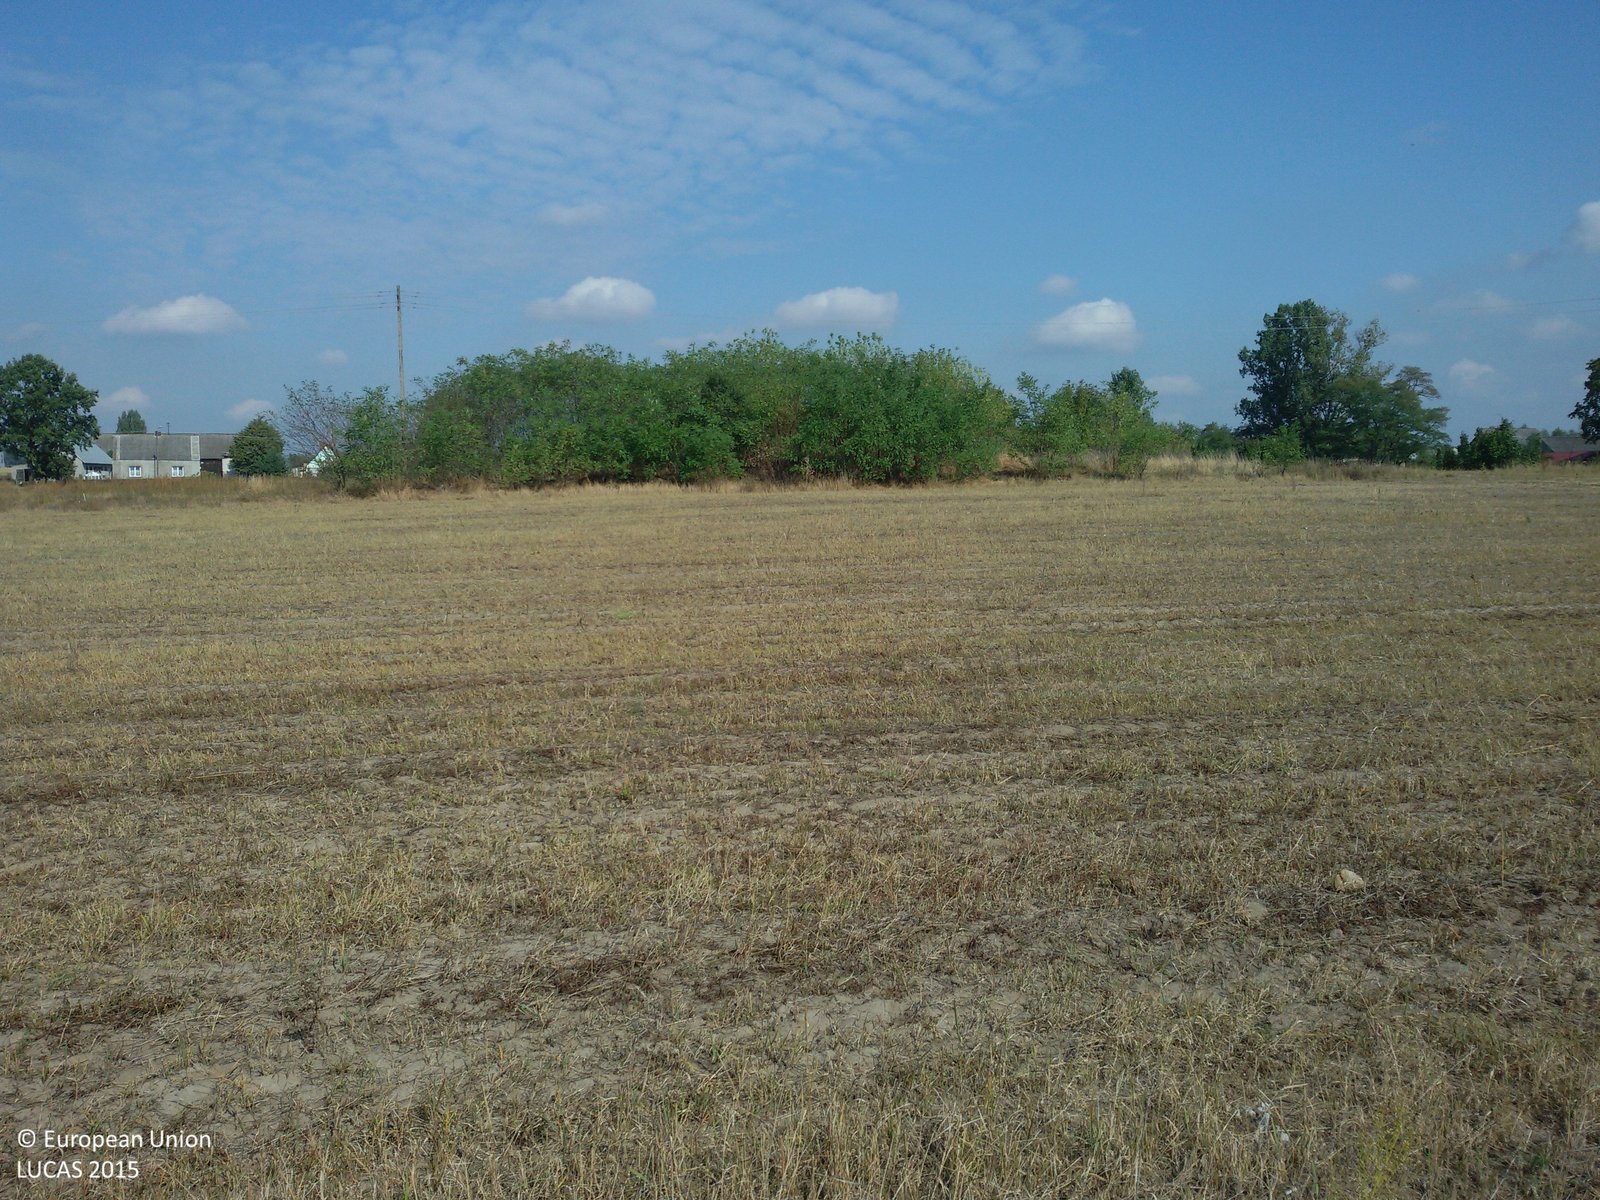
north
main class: Grassland
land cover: Spontaneously vegetated surfaces
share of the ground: > 75 %
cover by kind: herbaceous plants 100 %
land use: Semi-natural and natural areas not in use
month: September
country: PL
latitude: 51.4123
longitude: 18.8646
